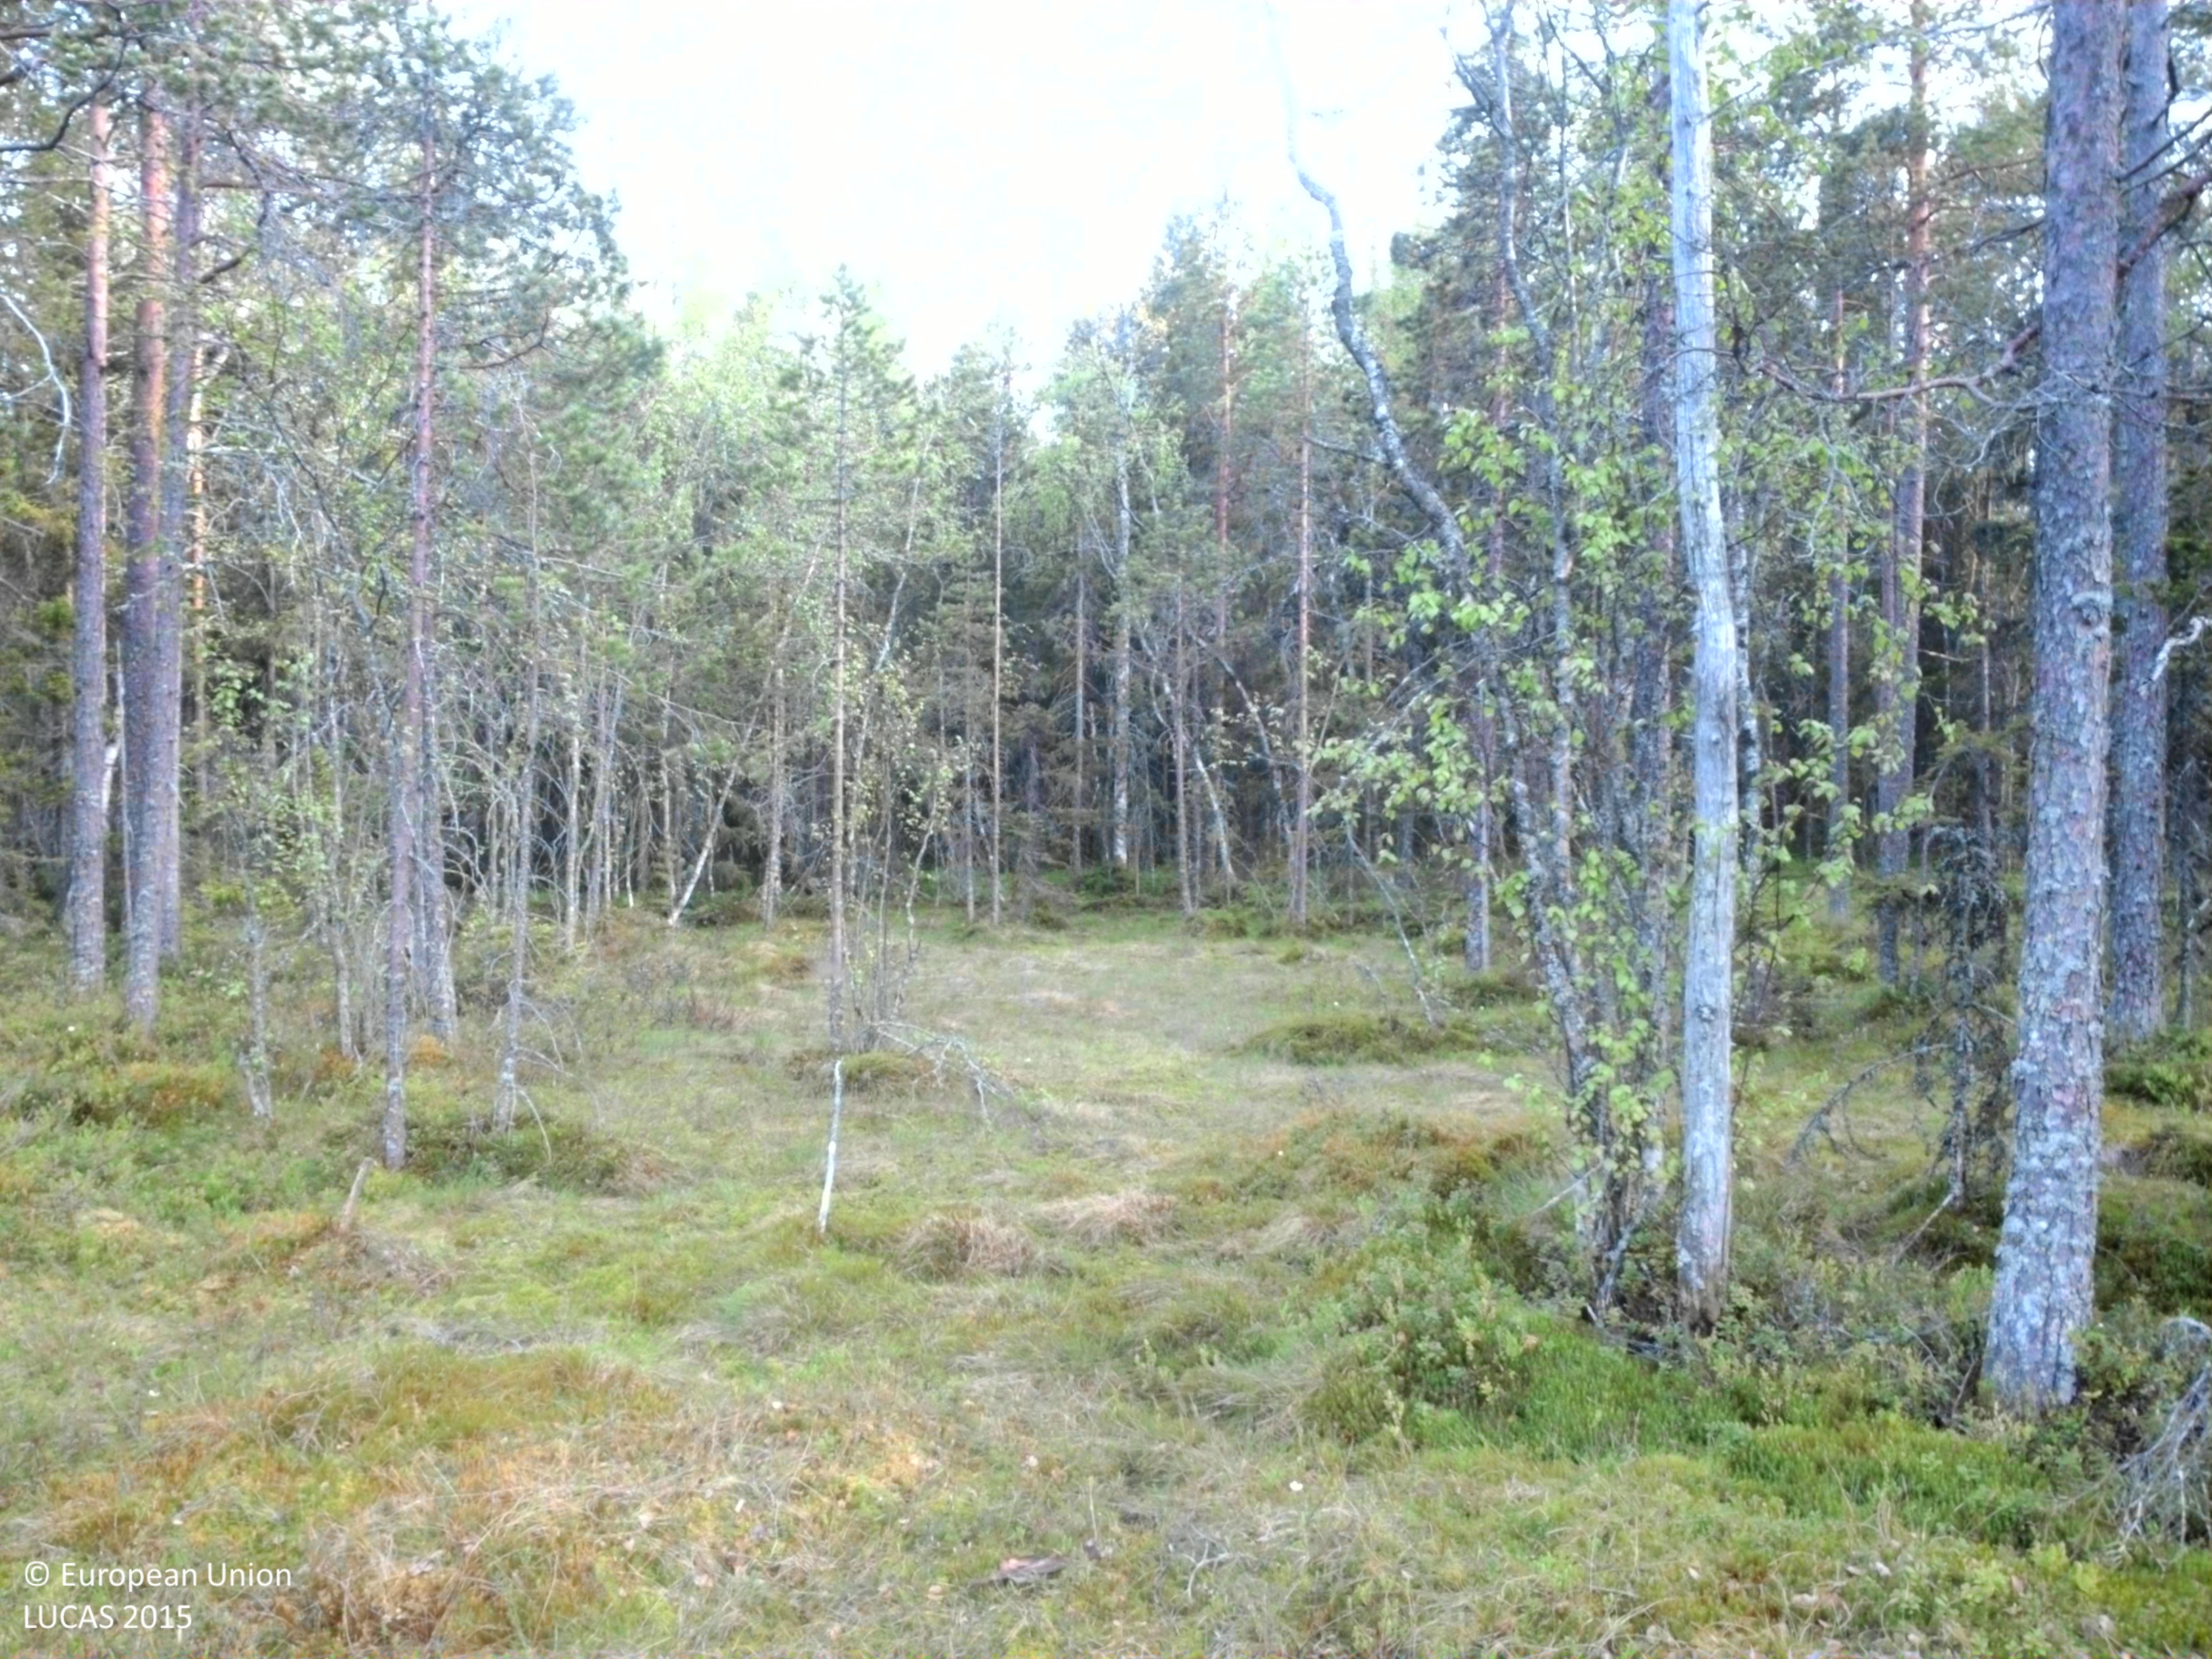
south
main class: Woodland
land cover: Pine dominated mixed woodland
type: boreal forest
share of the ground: 25 - 50 %
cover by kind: coniferous forest trees 30 %, shrubs 20 %, herbaceous plants 20 %, lichens and mosses 20 %, broadleaved forest trees 10 %
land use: Forestry
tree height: > 5 m
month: June
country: SE
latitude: 63.8557
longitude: 20.6635
